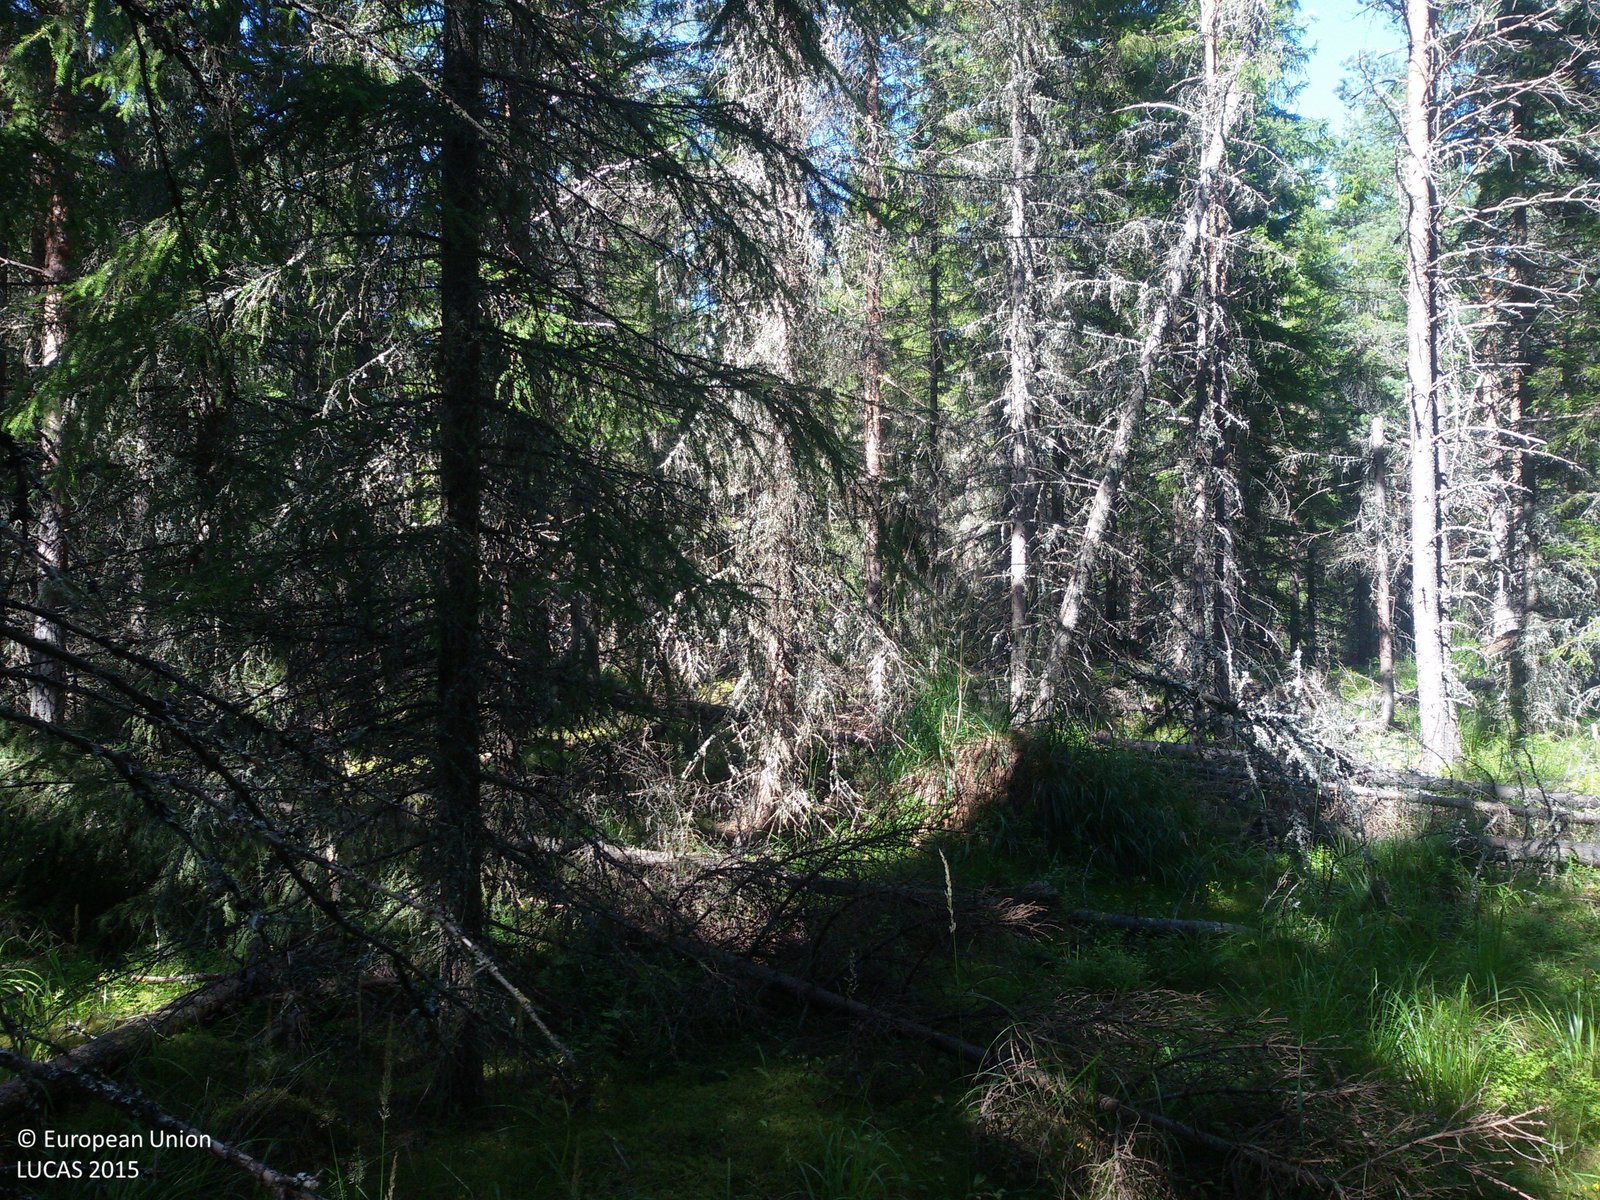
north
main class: Woodland
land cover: Spruce dominated coniferous woodland
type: boreal forest
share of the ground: > 75 %
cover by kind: coniferous forest trees 80 %, lichens and mosses 10 %, shrubs 5 %, herbaceous plants 5 %
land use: Forestry
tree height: > 5 m
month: August
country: SE
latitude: 60.8628
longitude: 16.4862
